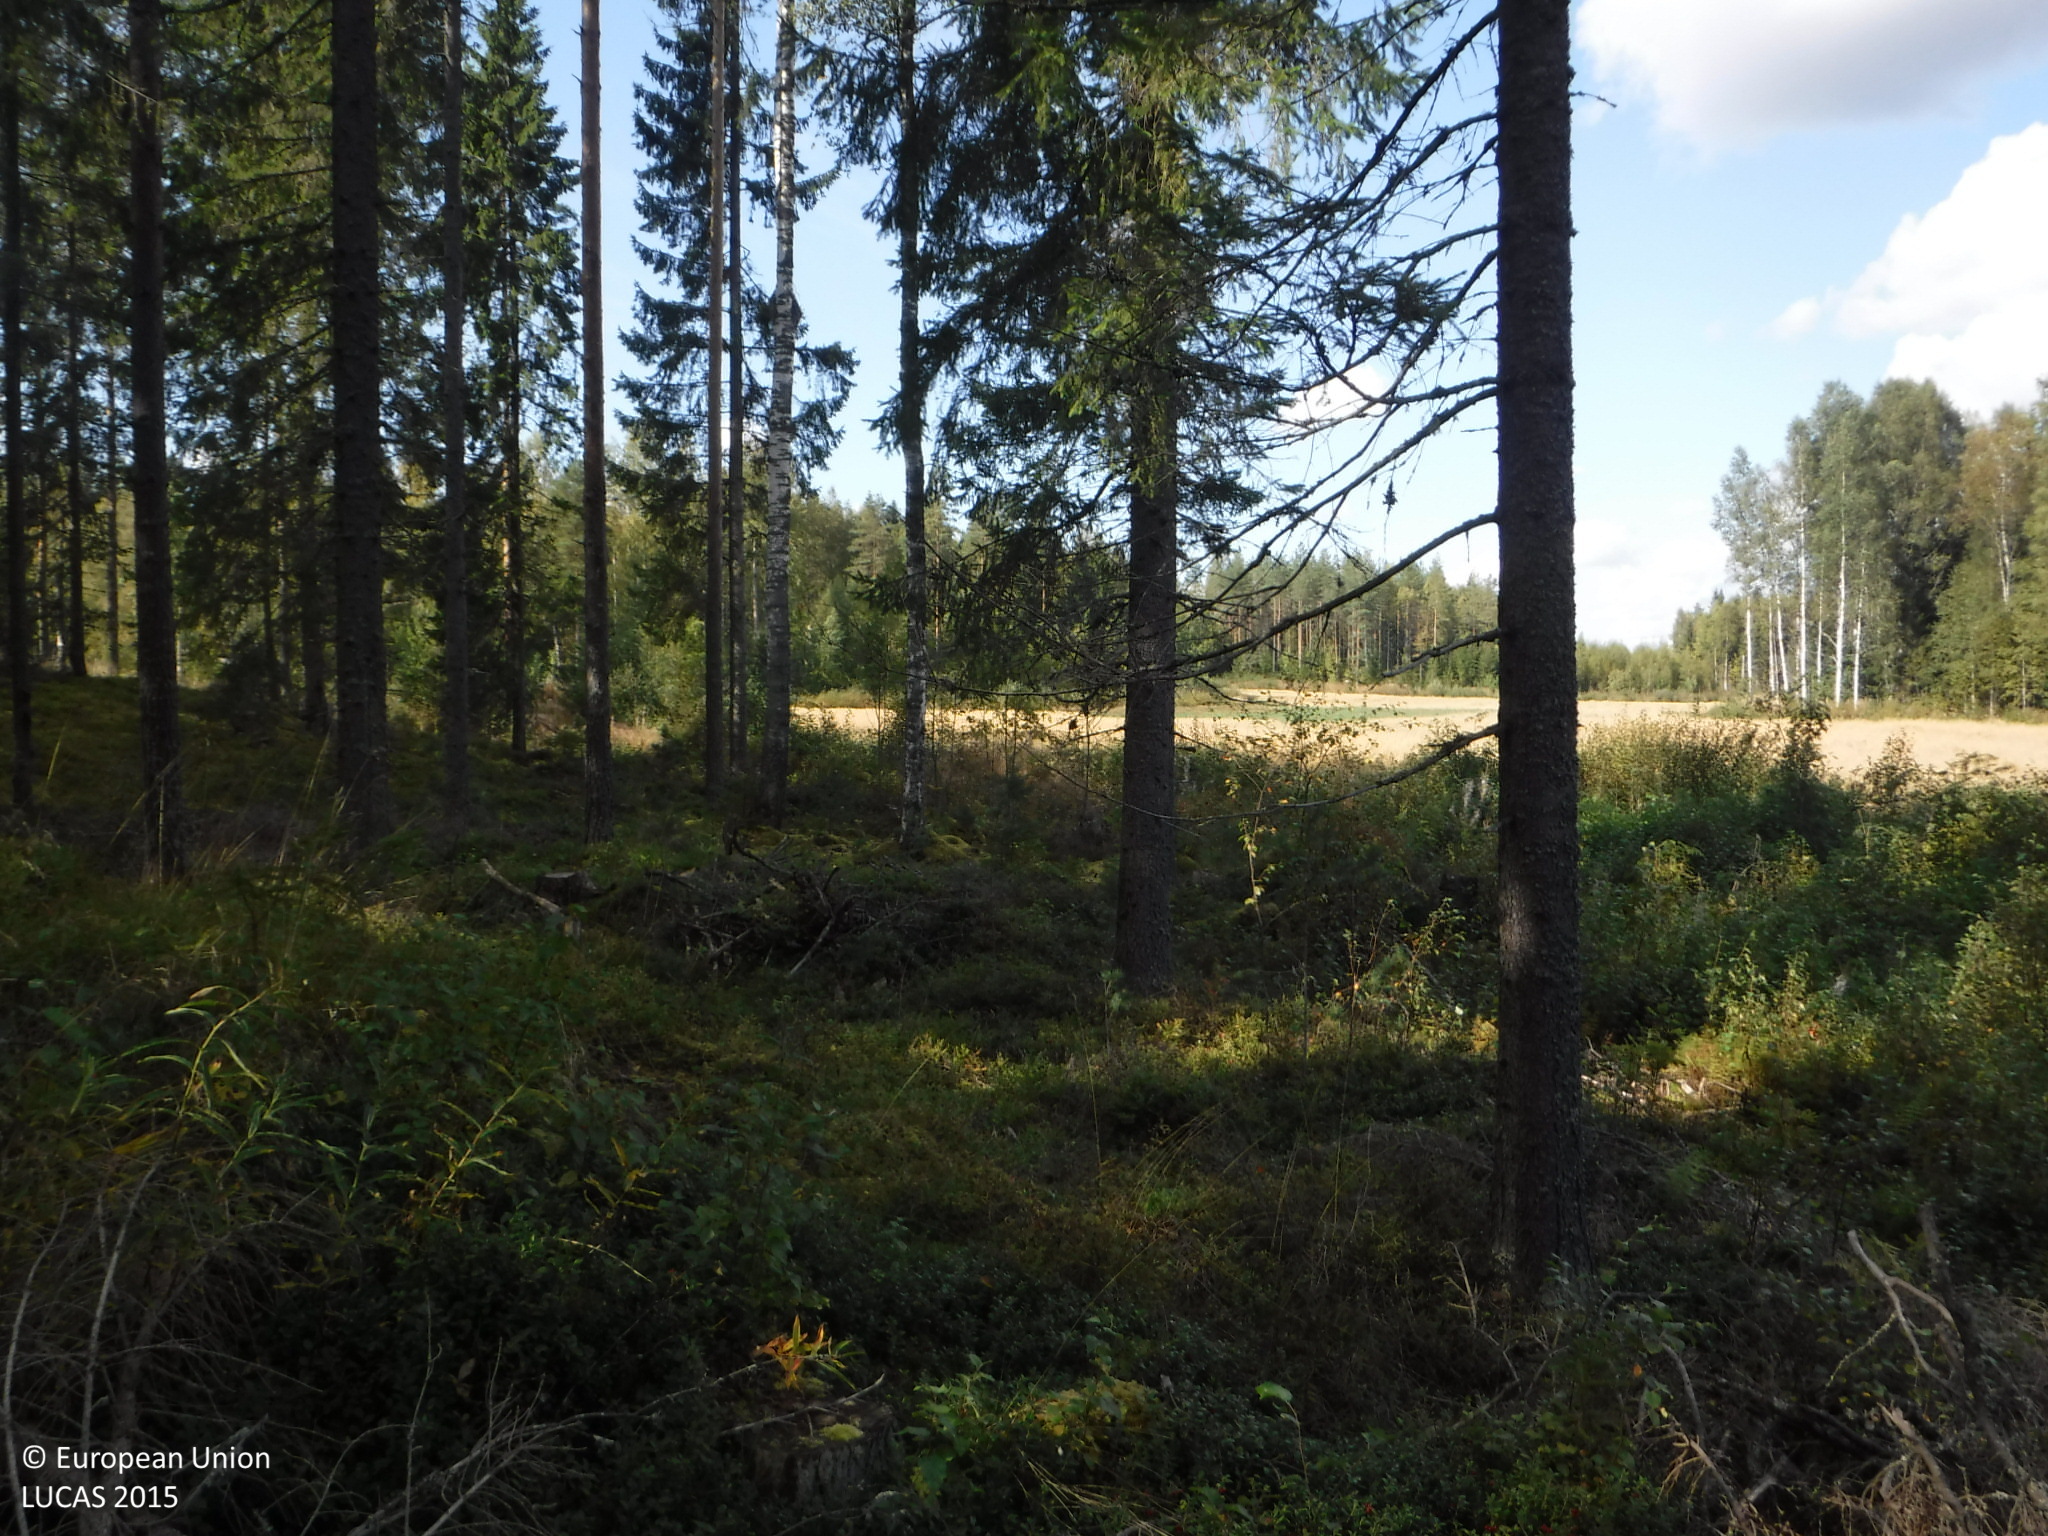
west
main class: Woodland
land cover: Spruce dominated coniferous woodland
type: boreal forest
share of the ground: 25 - 50 %
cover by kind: lichens and mosses 45 %, coniferous forest trees 40 %, shrubs 15 %
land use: Forestry
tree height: > 5 m
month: September
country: FI
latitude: 61.7332
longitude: 22.3825
